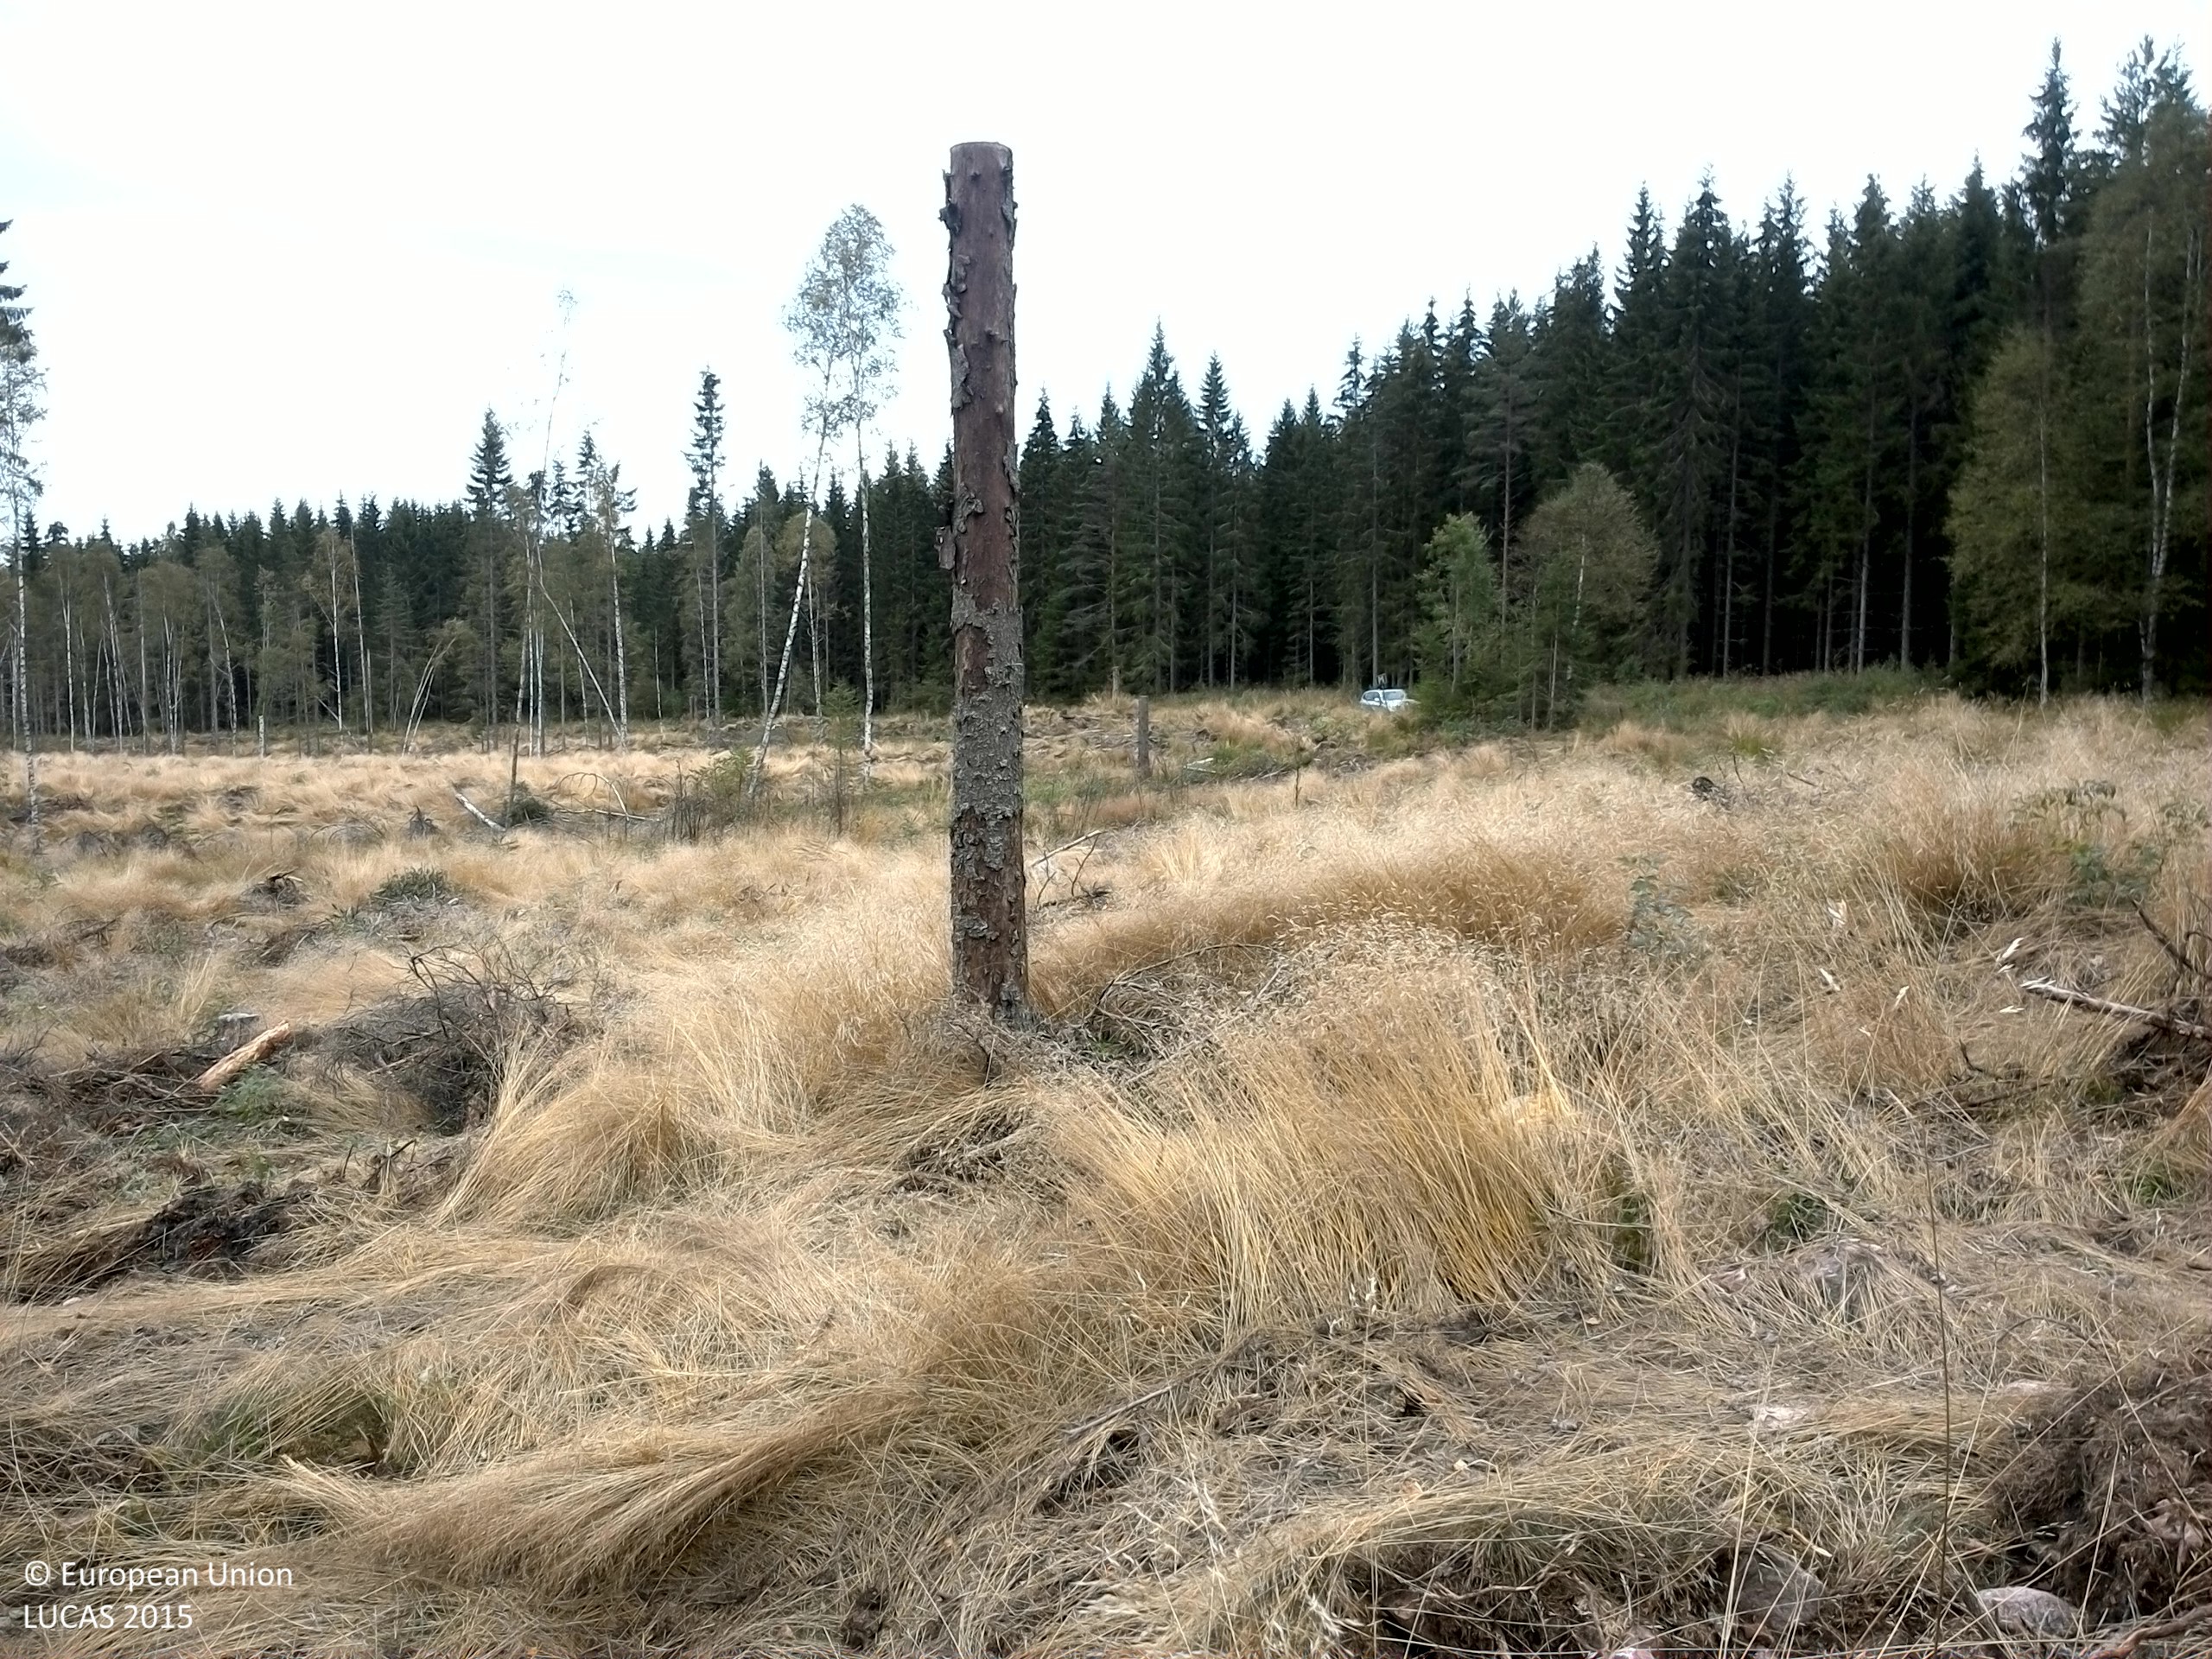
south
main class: Grassland
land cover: Grassland with sparse tree/shrub cover
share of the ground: 50 - 75 %
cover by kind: herbaceous plants 55 %, consolidated bare surface 25 %, broadleaved forest trees 5 %, shrubs 5 %
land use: Forestry
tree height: > 5 m
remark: Clear cut
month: September
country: SE
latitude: 59.7615
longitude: 13.3917
